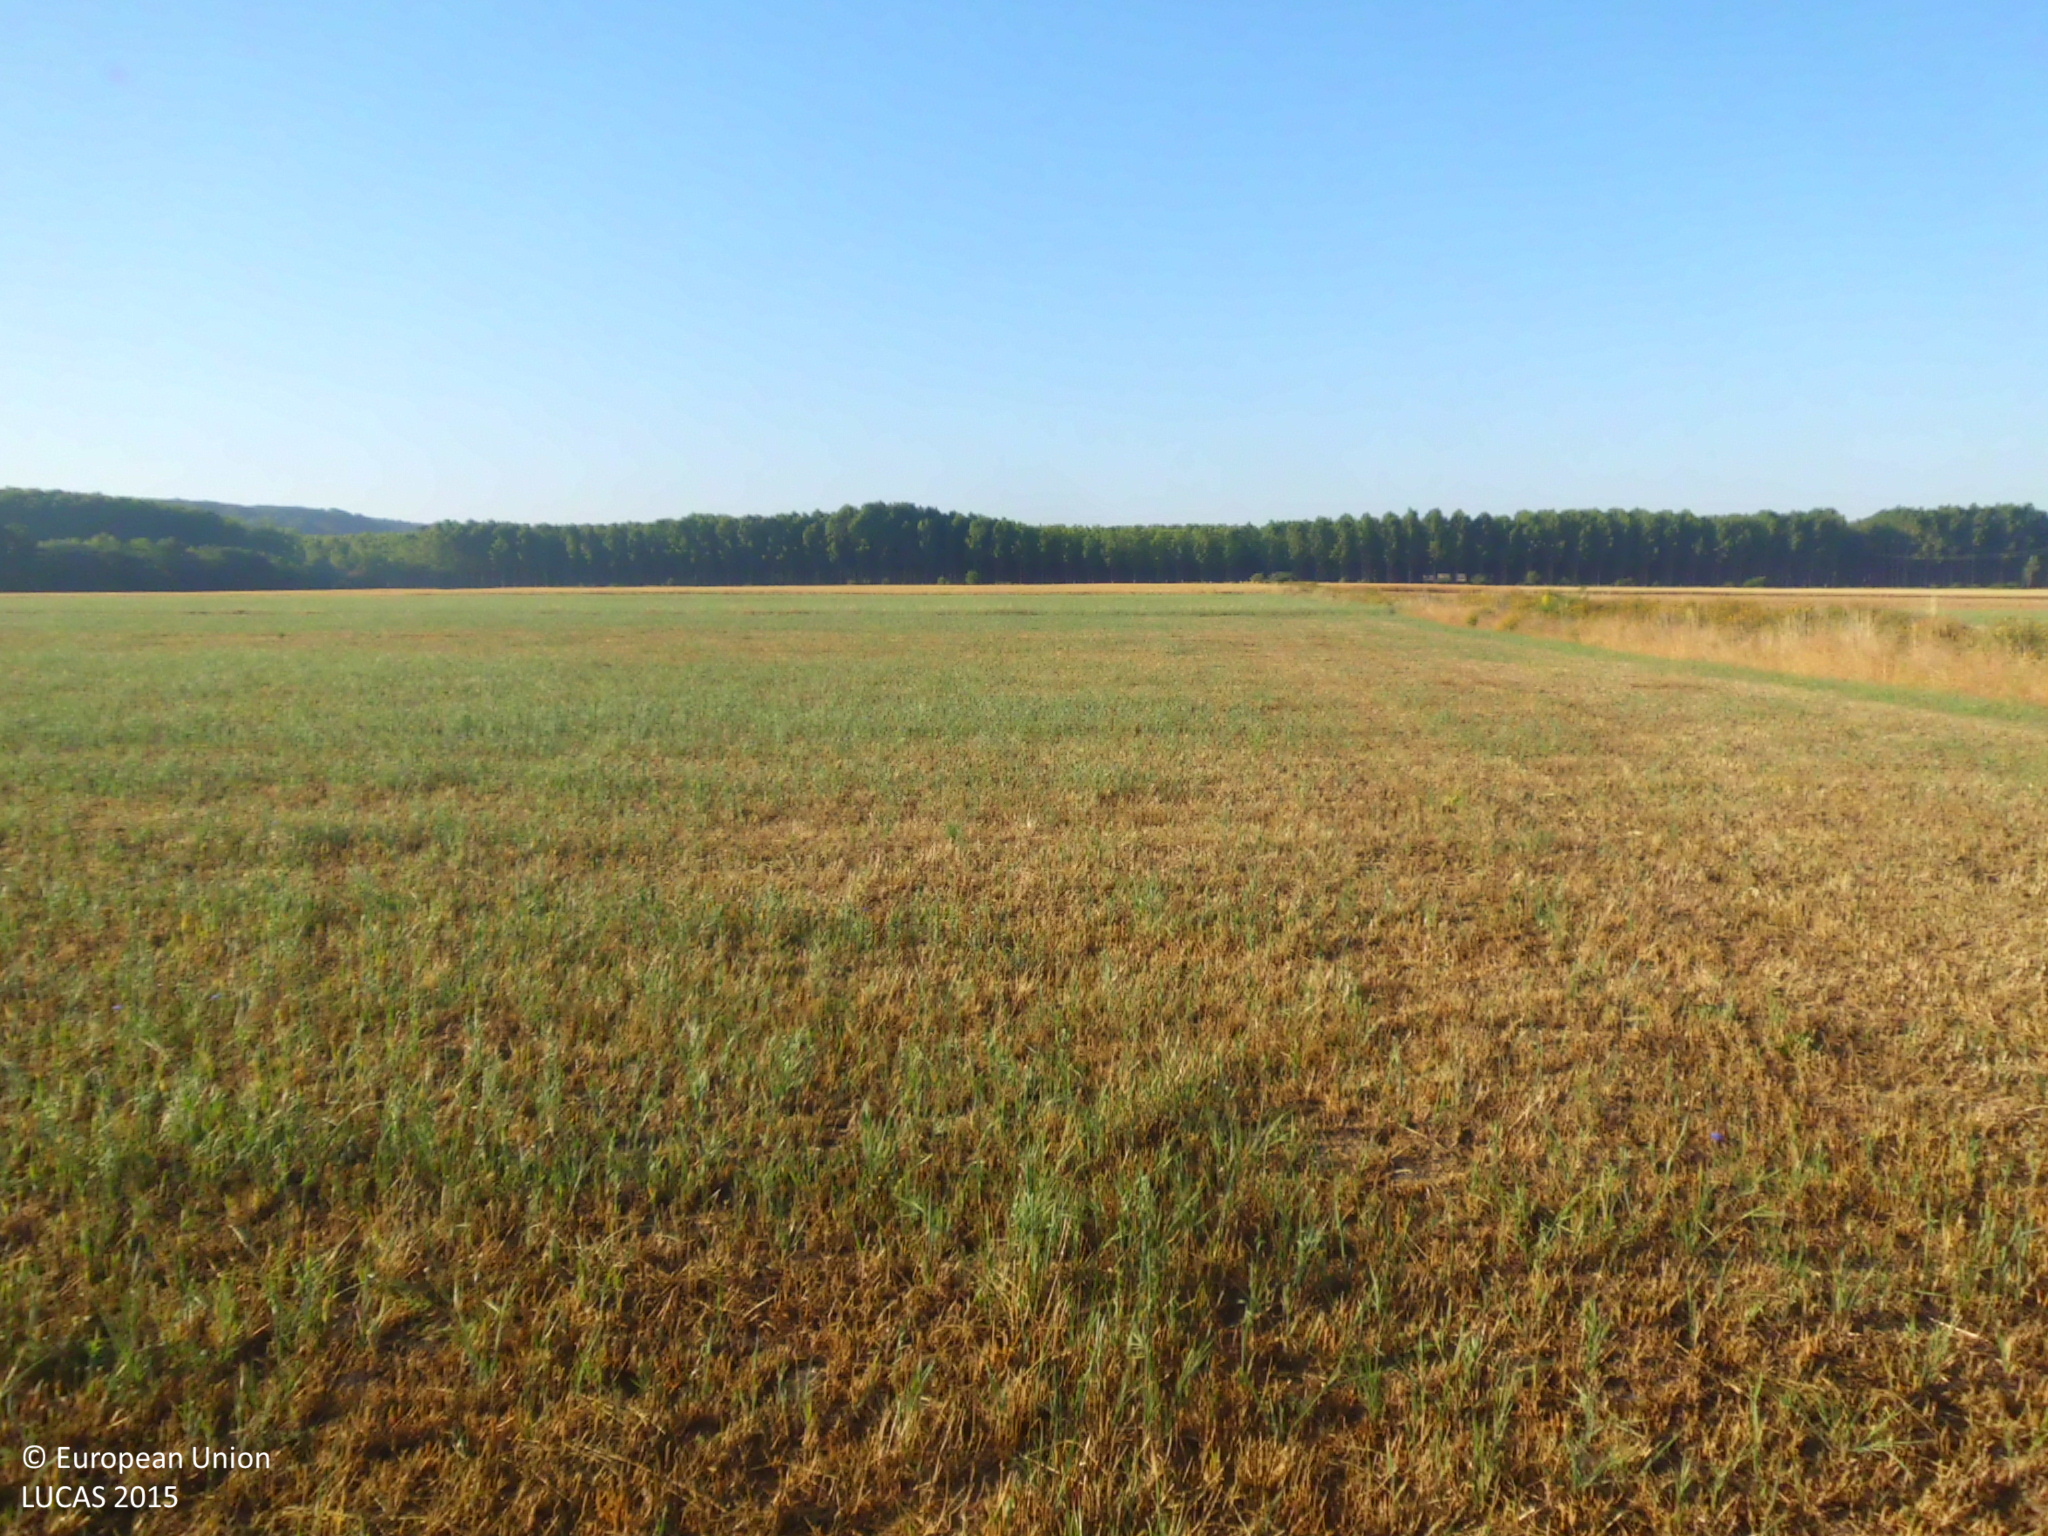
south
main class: Grassland
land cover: Spontaneously vegetated surfaces
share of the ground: 50 - 75 %
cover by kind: herbaceous plants 60 %, unconsolidated bare surface 40 %
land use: Fallow land
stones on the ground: < 10 %
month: June
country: ES
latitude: 42.6440
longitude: -5.0276
